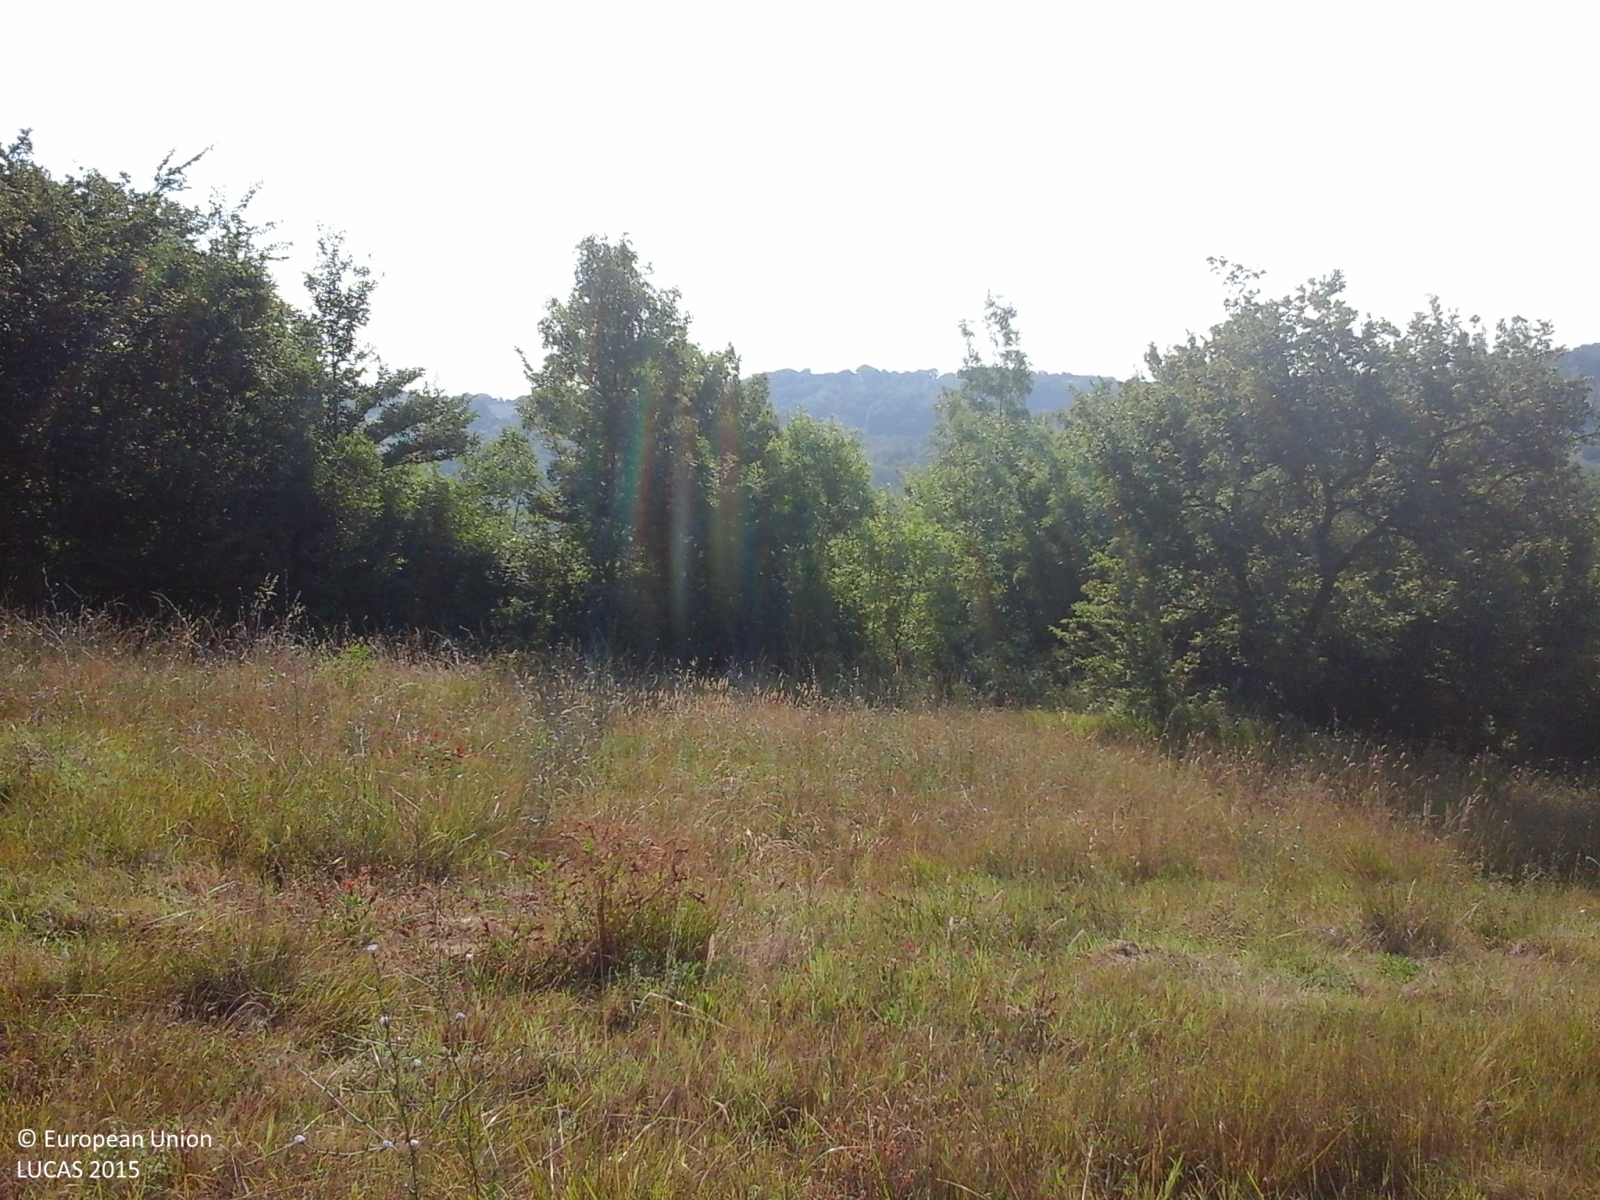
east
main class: Cropland
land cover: Nuts trees
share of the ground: 25 - 50 %
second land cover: Grassland without tree/shrub cover
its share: > 75 %
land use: Agriculture (excluding fallow land and kitchen gardens)
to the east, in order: Nuts trees; Grassland without tree/shrub cover; Broadleaved woodland
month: July
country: IT
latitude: 41.0977
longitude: 14.6849
